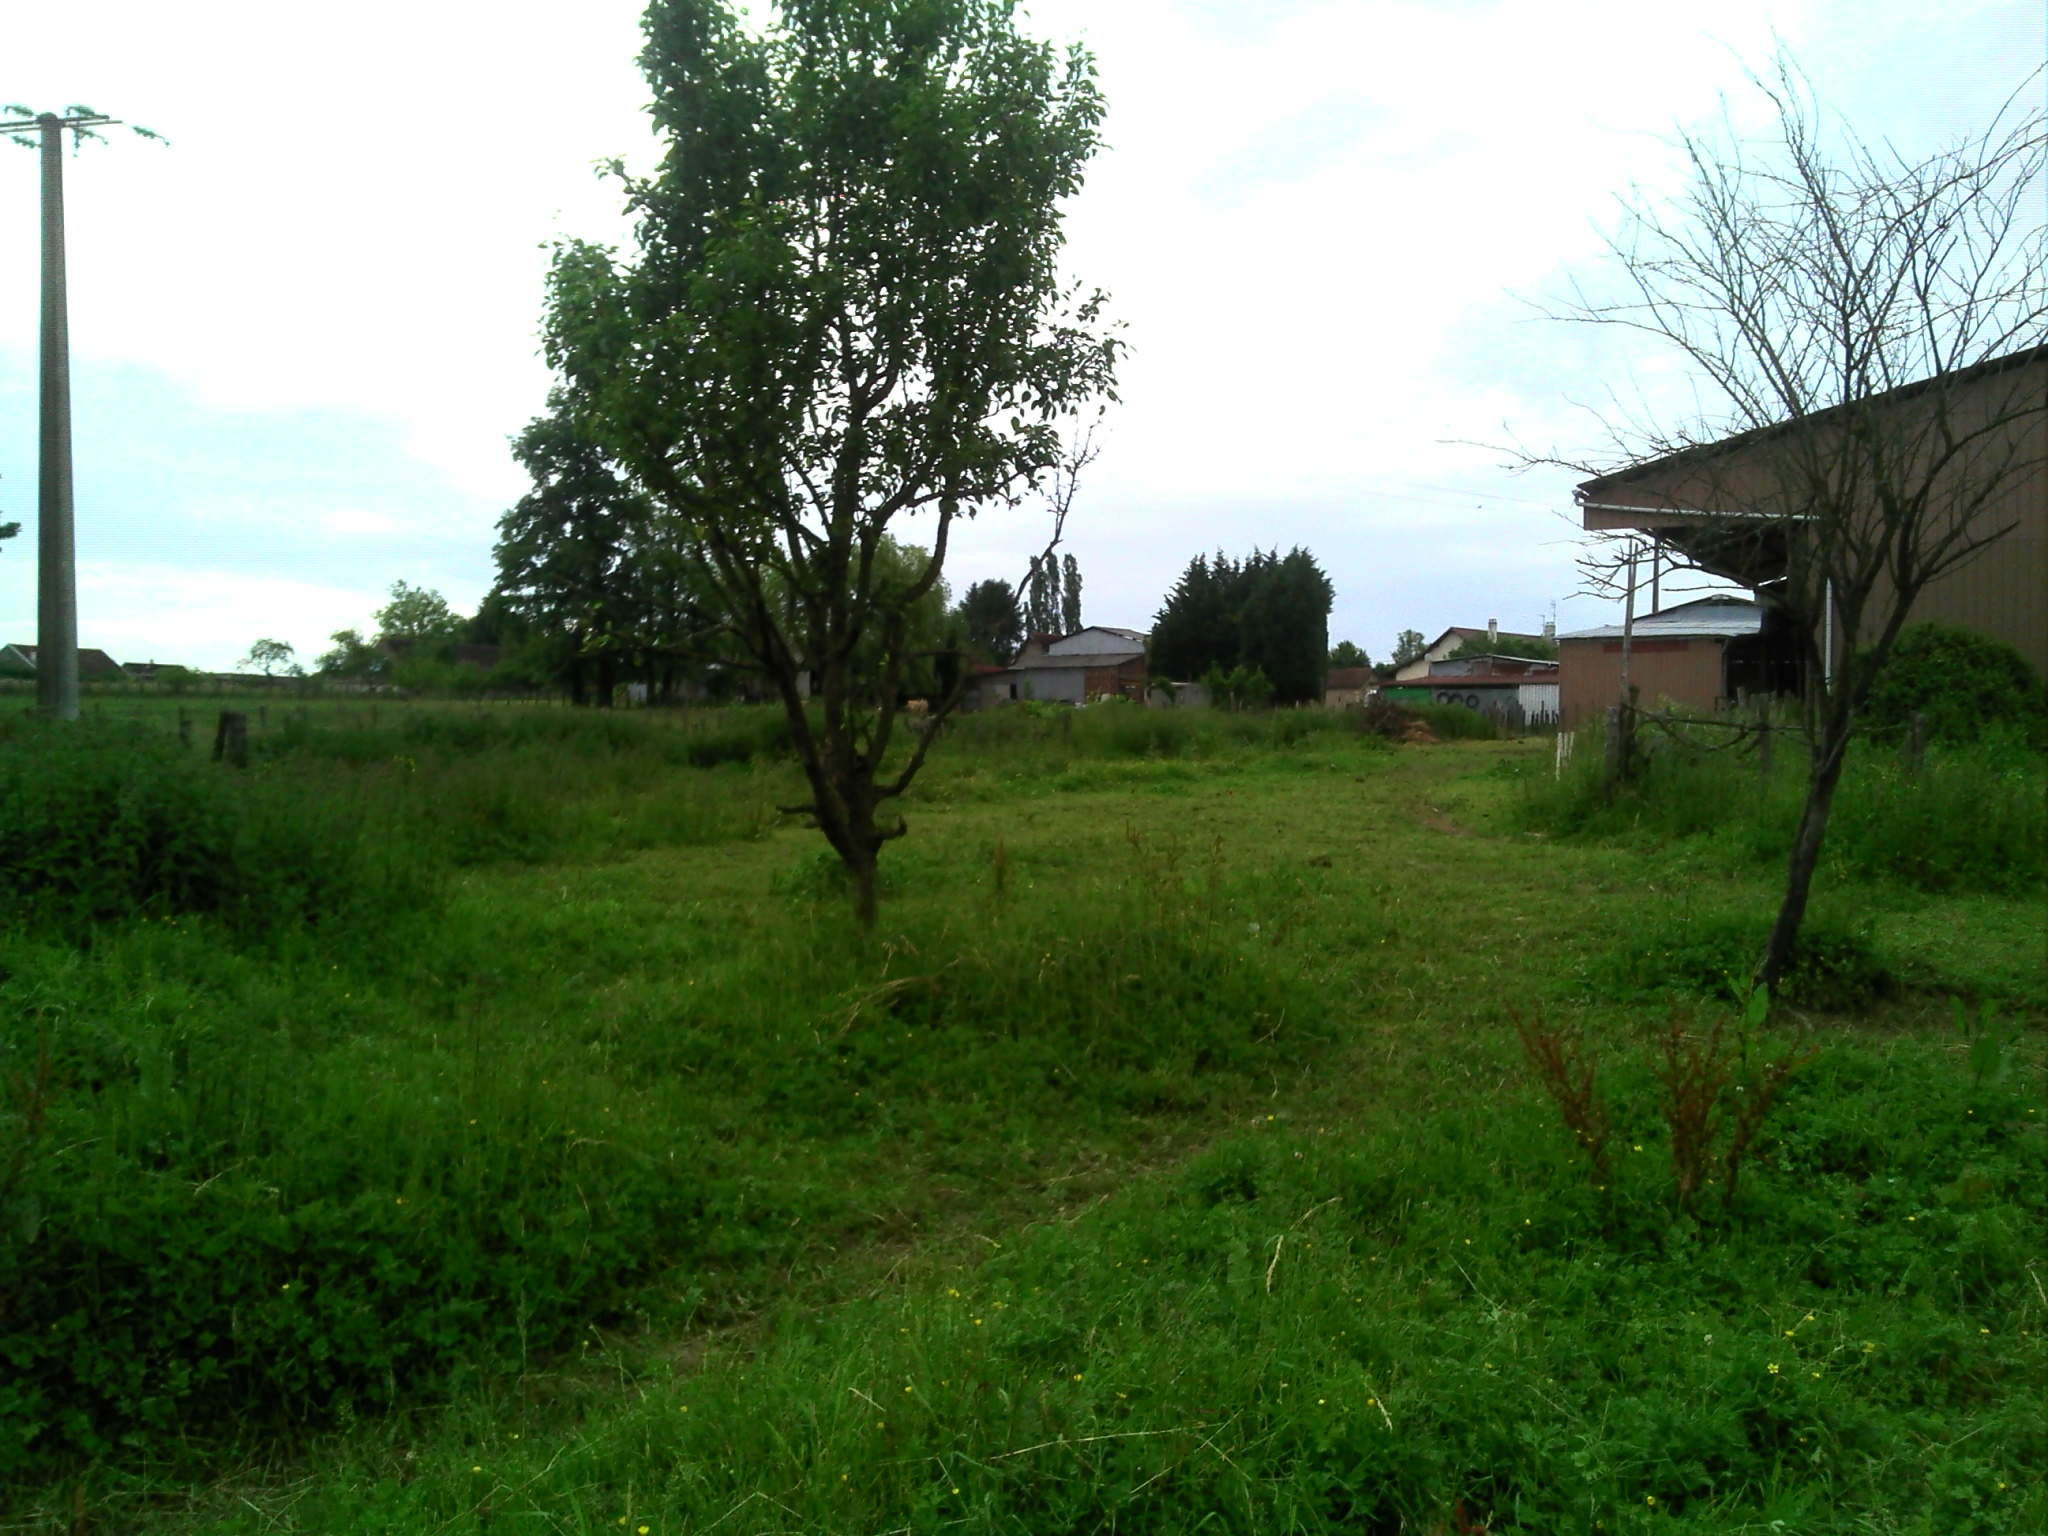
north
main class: Grassland
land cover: Grassland with sparse tree/shrub cover
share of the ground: > 75 %
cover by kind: herbaceous plants 95 %, broadleaved forest trees 5 %
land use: Agriculture (excluding fallow land and kitchen gardens)
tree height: < 5 m
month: May
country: FR
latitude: 46.5948
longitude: 5.3947
